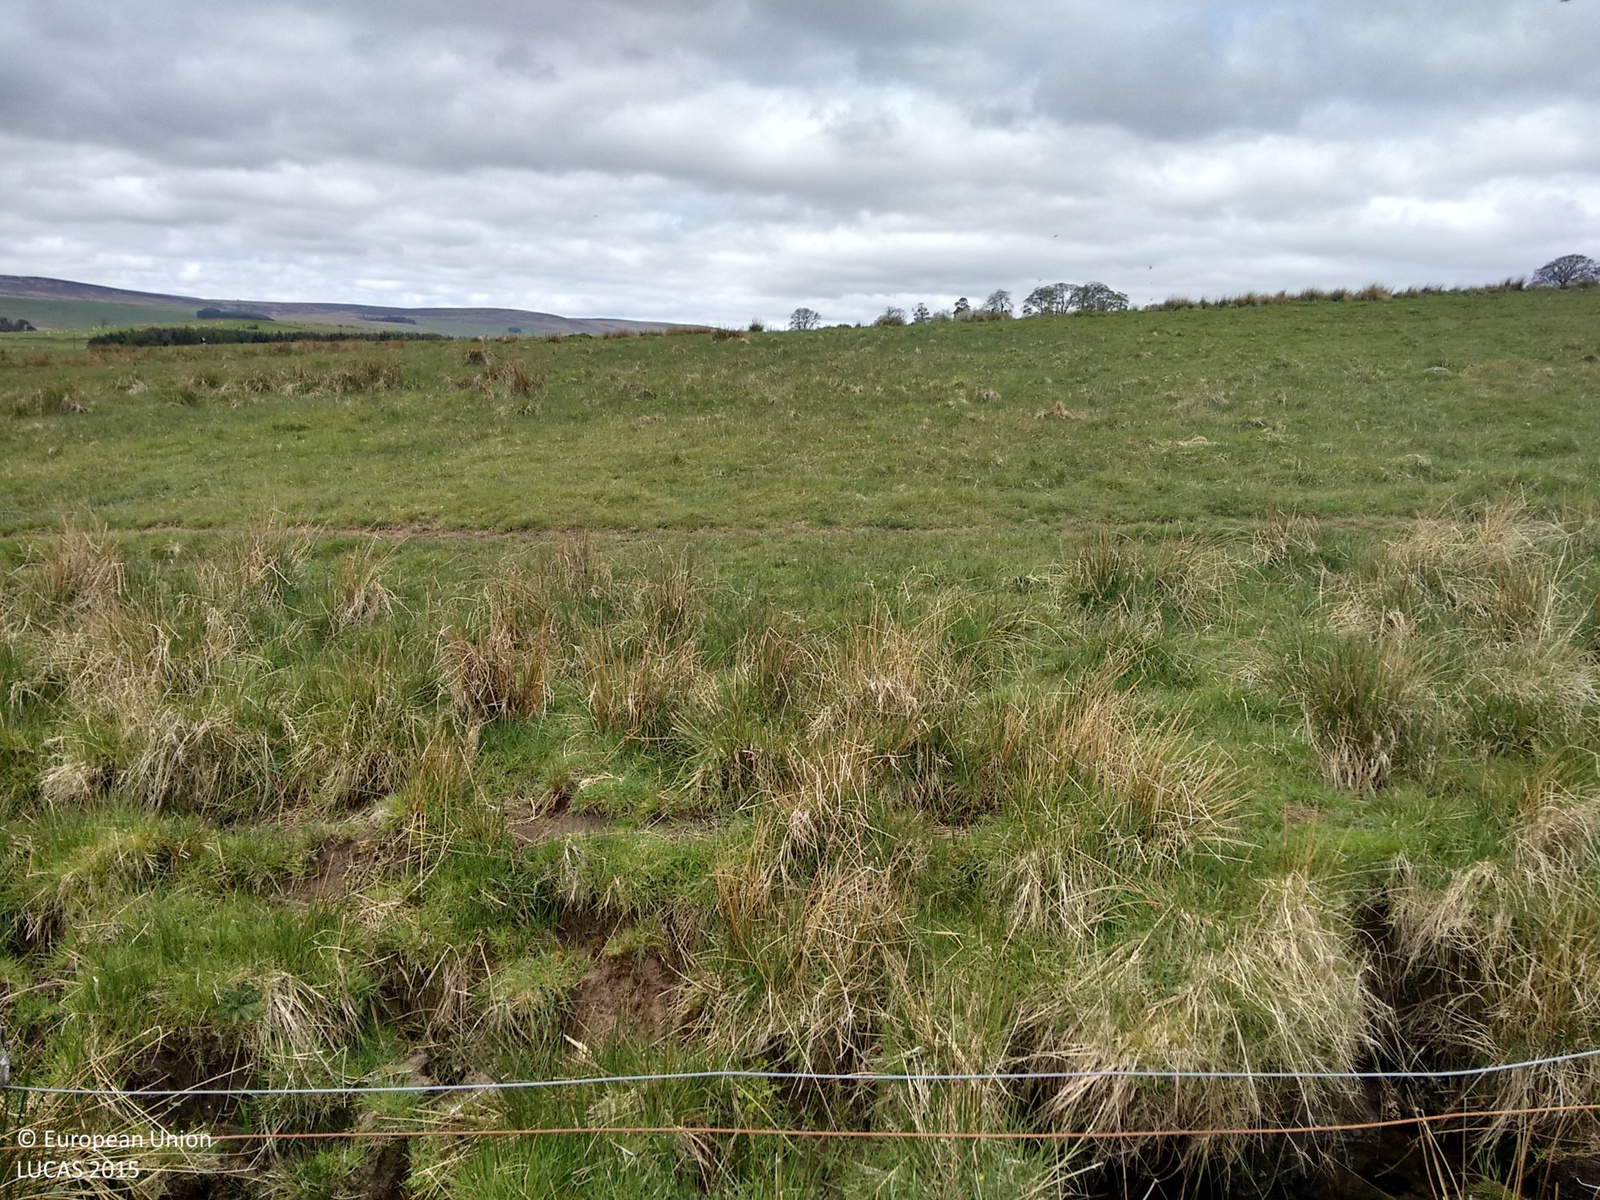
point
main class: Grassland
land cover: Grassland without tree/shrub cover
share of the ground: > 75 %
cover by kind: herbaceous plants 100 %
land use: Agriculture (excluding fallow land and kitchen gardens)
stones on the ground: < 10 %
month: May
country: GB
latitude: 55.2259
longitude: -2.1460
